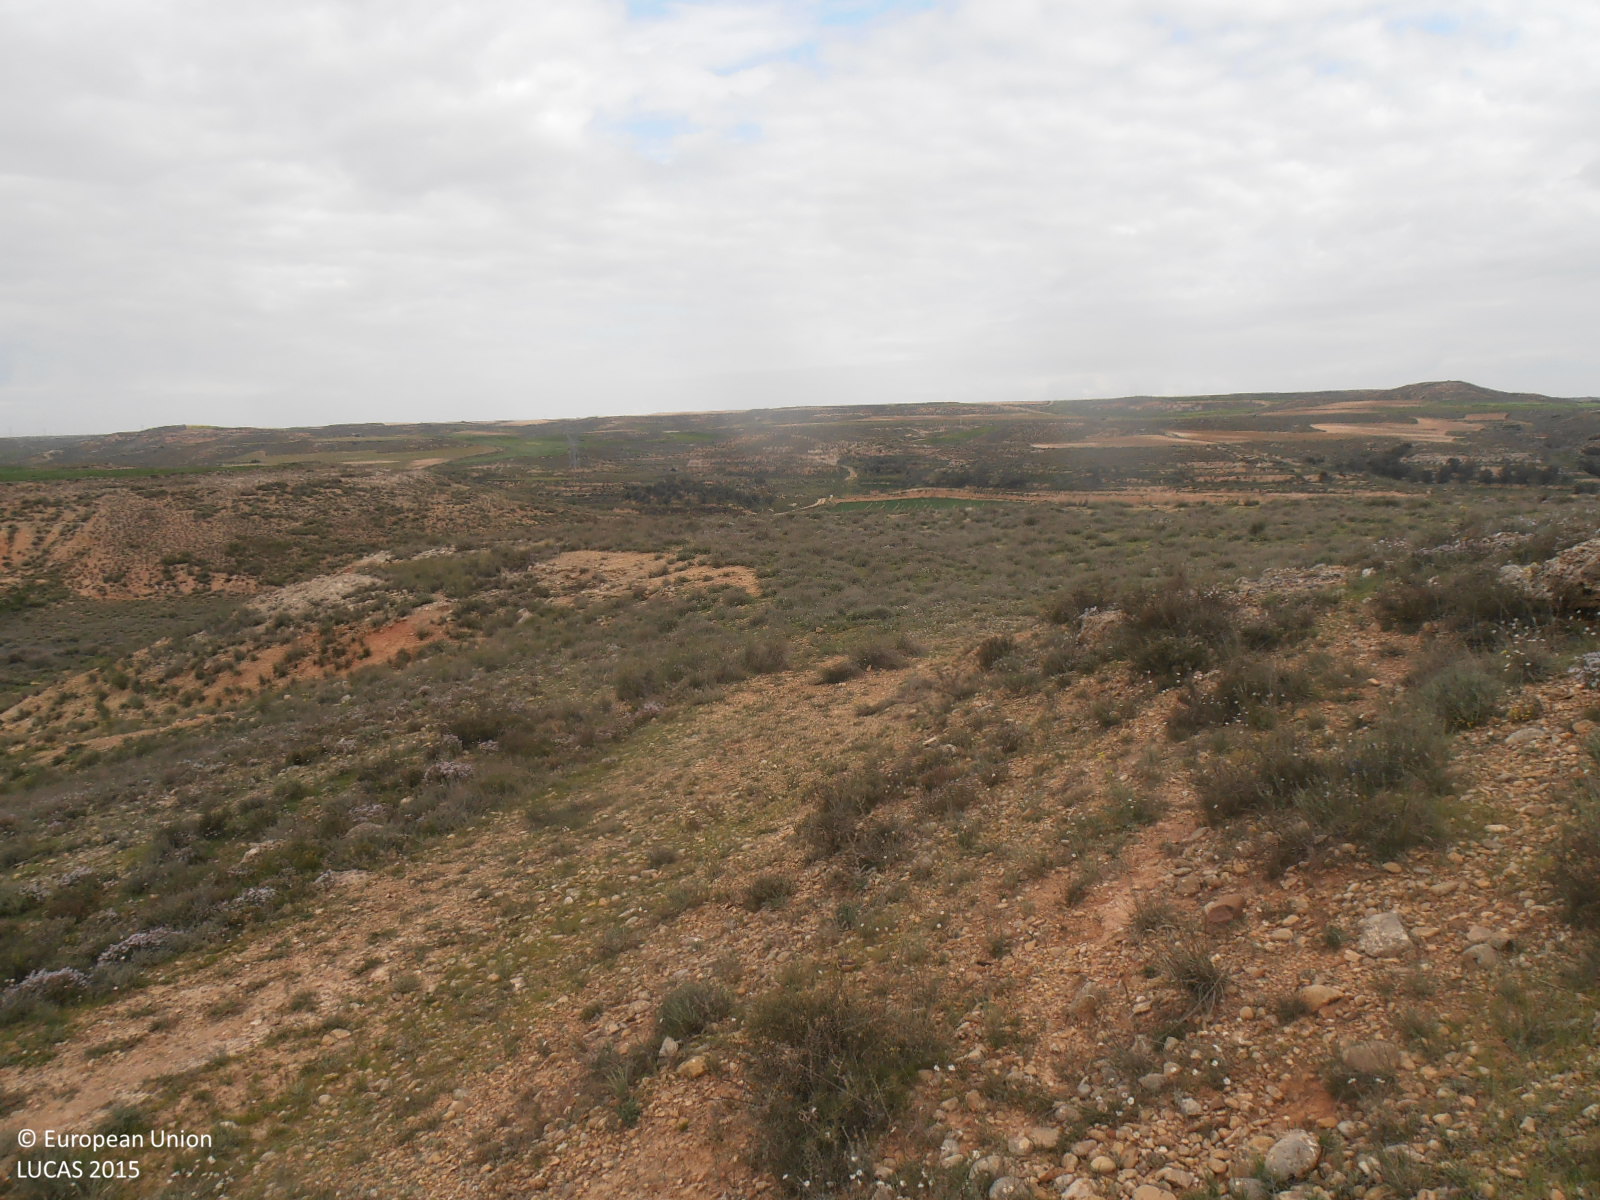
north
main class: Shrubland
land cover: Shrubland without tree cover
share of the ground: > 75 %
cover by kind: shrubs 70 %, herbaceous plants 15 %, consolidated bare surface 15 %
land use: Semi-natural and natural areas not in use
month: April
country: ES
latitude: 41.2273
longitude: -0.3812
